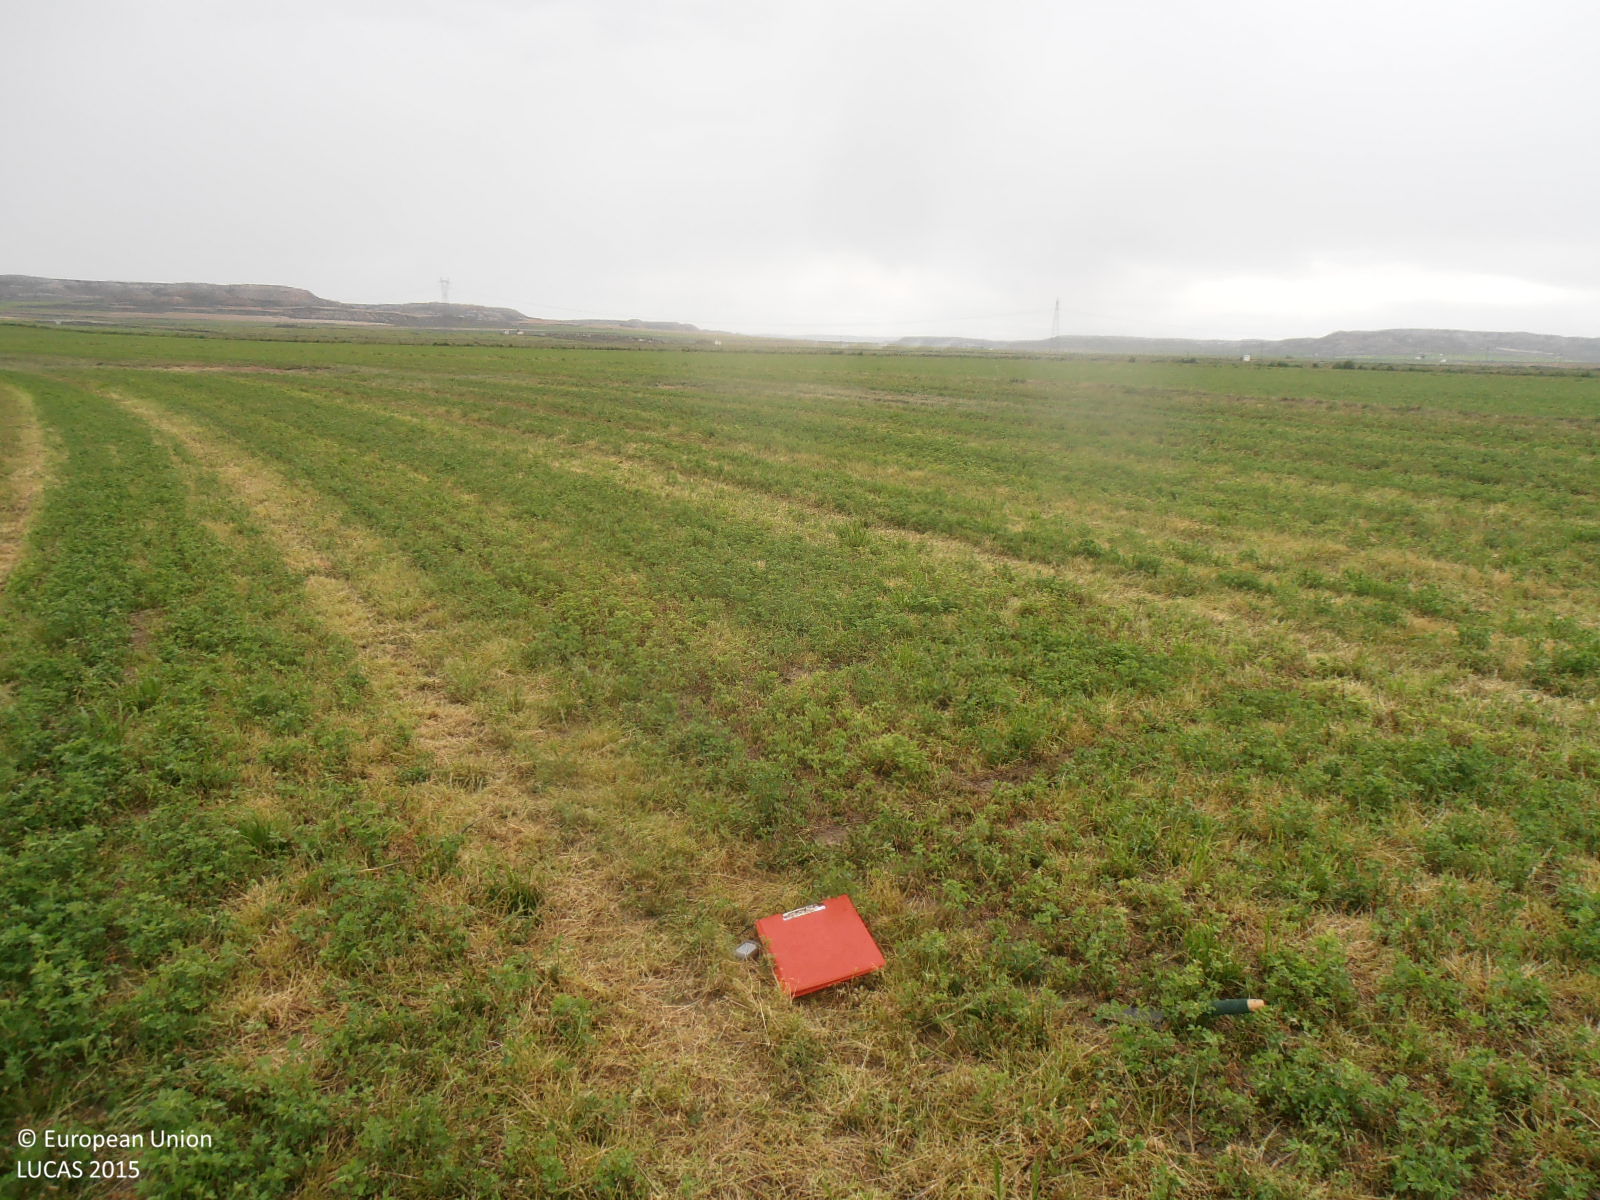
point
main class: Cropland
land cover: Lucerne
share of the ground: > 75 %
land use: Agriculture (excluding fallow land and kitchen gardens)
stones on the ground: < 10 %
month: April
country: ES
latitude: 41.4420
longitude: -0.4175
